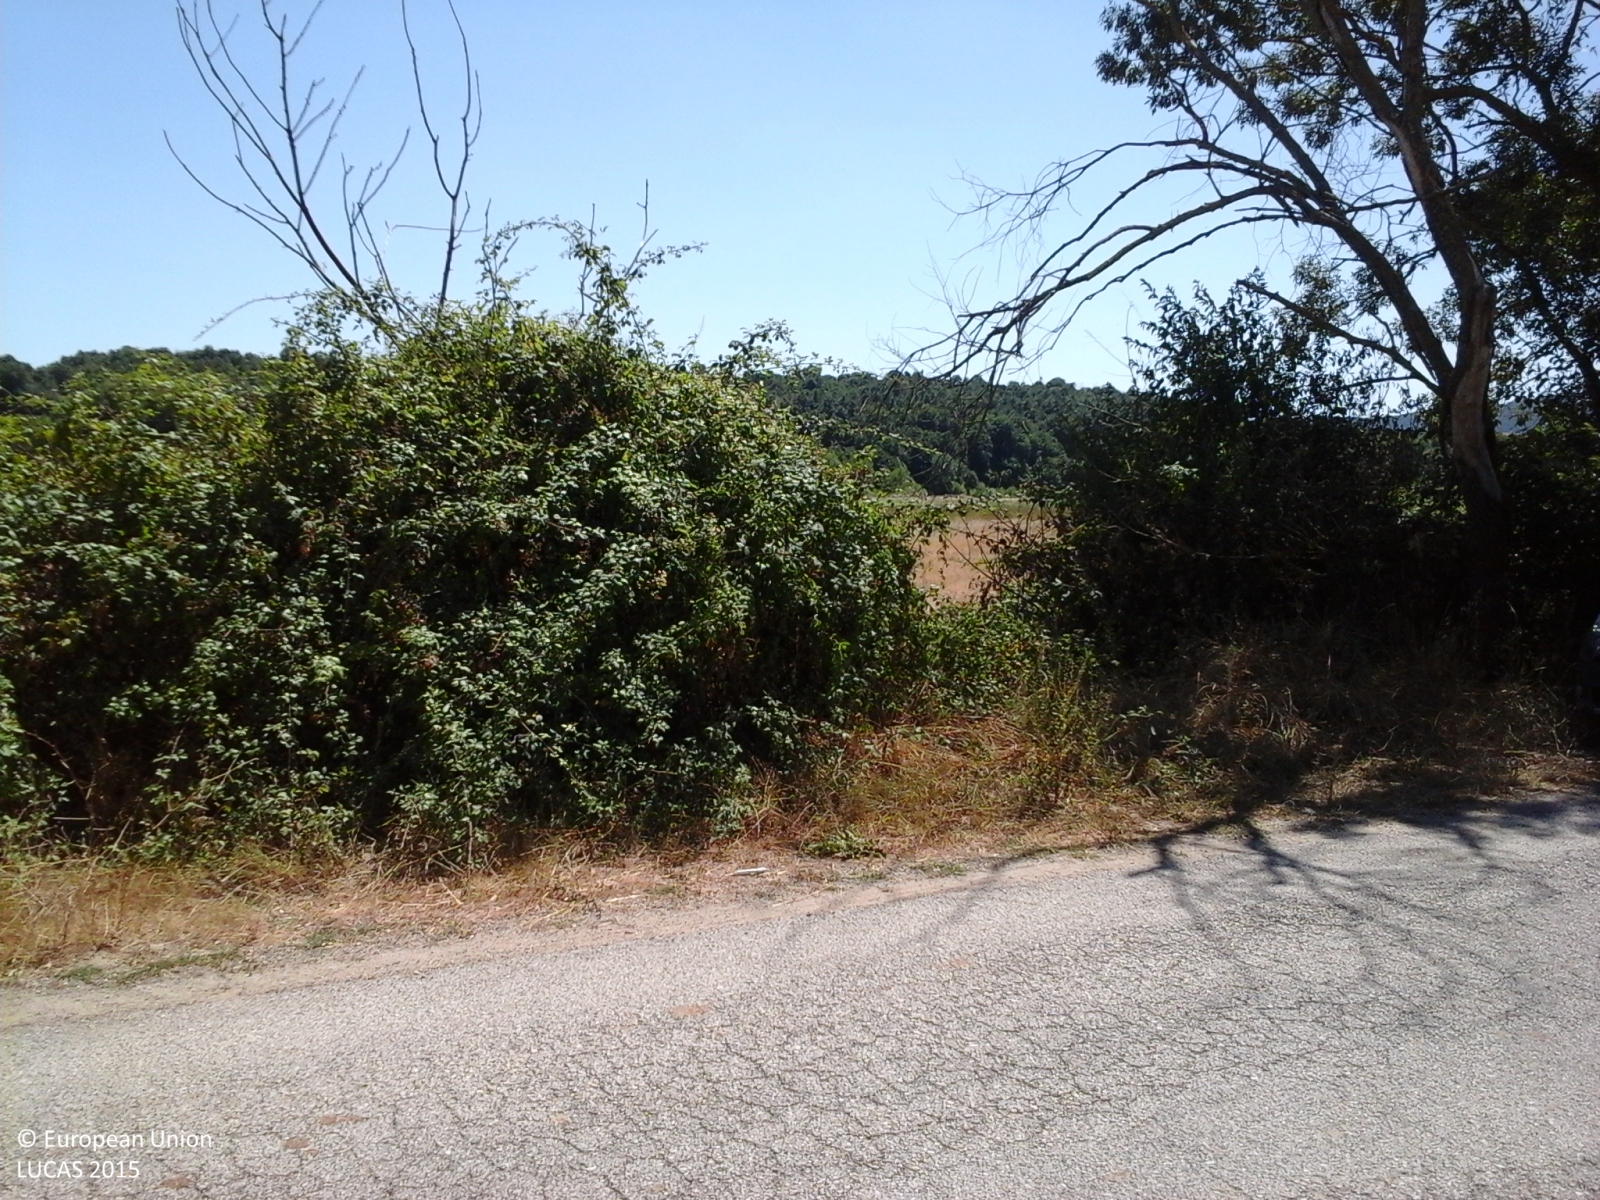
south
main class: Cropland
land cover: Temporary grasslands
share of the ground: > 75 %
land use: Agriculture (excluding fallow land and kitchen gardens)
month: August
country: IT
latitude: 42.6415
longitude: 11.5924
